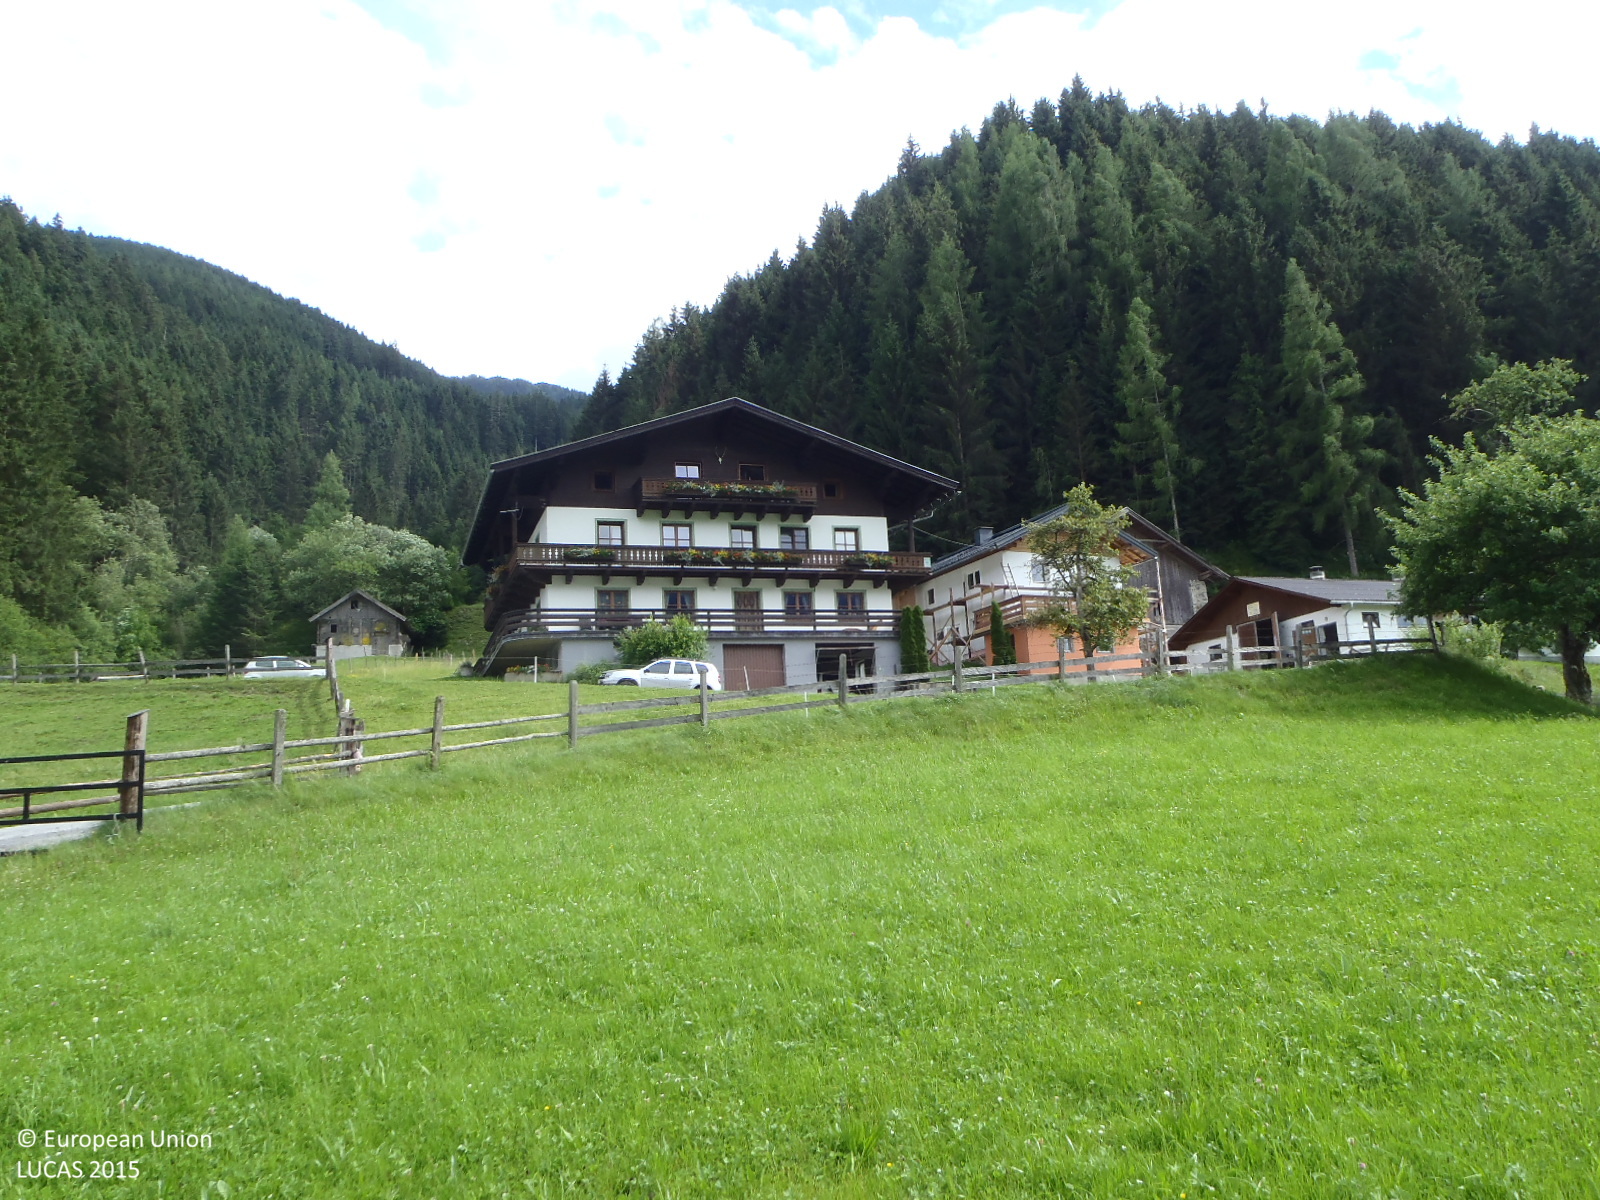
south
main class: Grassland
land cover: Grassland without tree/shrub cover
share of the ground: > 75 %
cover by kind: herbaceous plants 100 %
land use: Agriculture (excluding fallow land and kitchen gardens)
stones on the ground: < 10 %
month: June
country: AT
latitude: 47.2763
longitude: 12.5230
